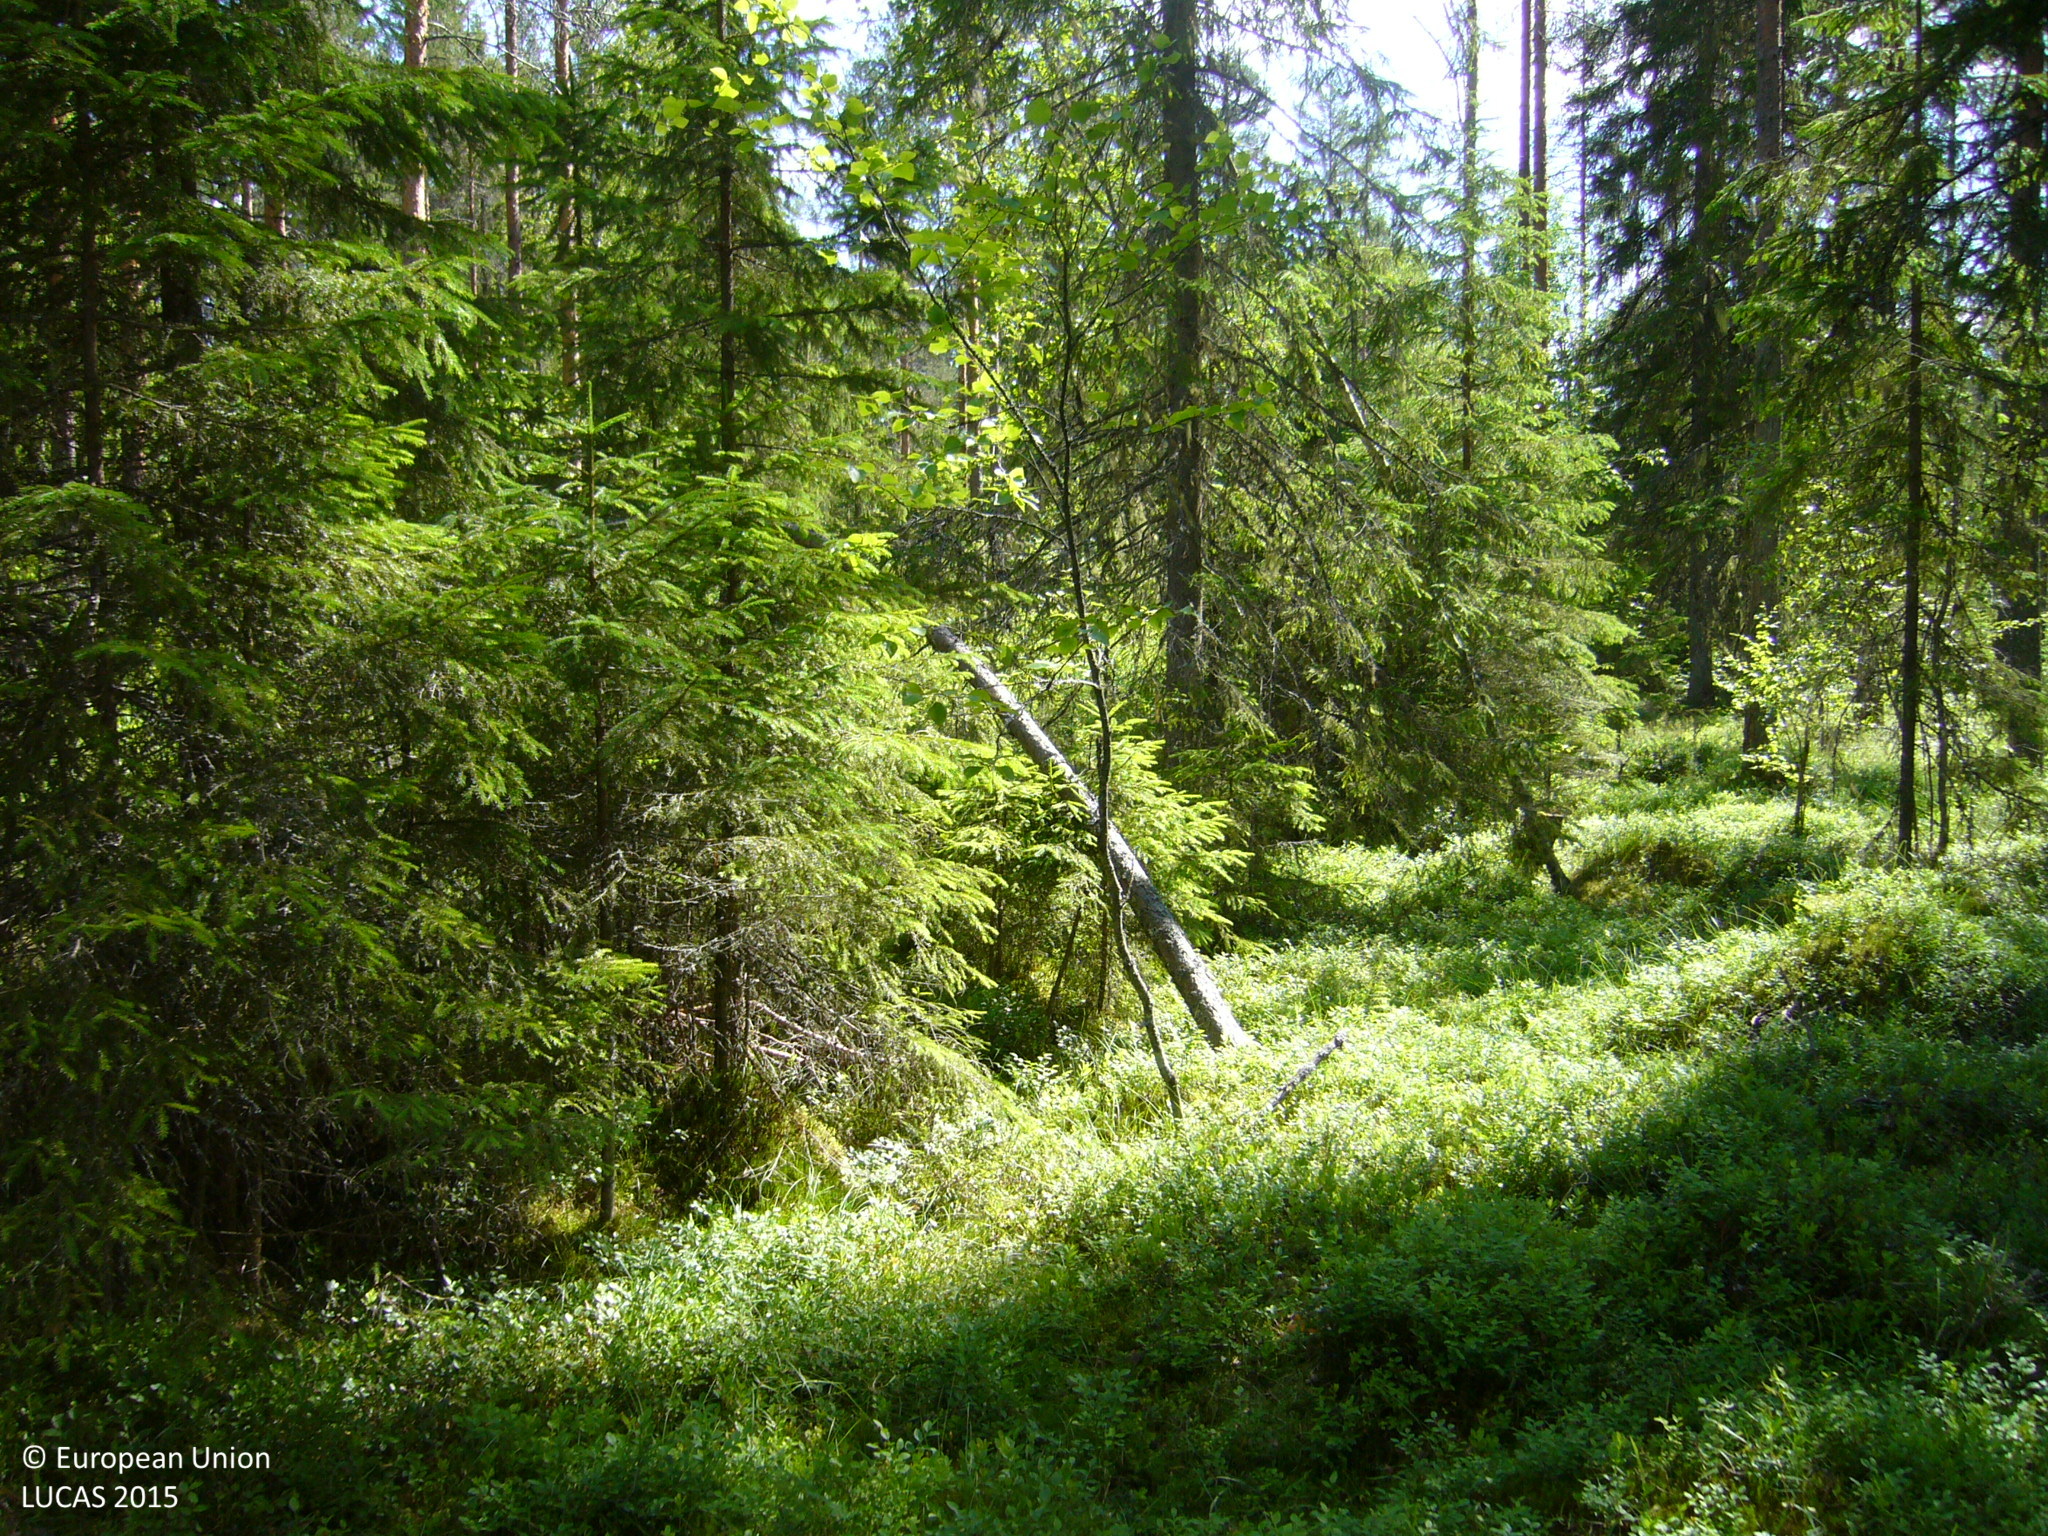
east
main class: Woodland
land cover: Spruce dominated coniferous woodland
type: boreal forest
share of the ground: 50 - 75 %
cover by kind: coniferous forest trees 50 %, shrubs 40 %, broadleaved forest trees 10 %
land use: Forestry
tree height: > 5 m
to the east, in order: Spruce dominated coniferous woodland; Ditches and canals; Spruce dominated coniferous woodland; Shruby margins; Ditches and canals; Grass margins; Tracks; Grass margins; Ditches and canals; Shruby margins; Pine dominated coniferous woodland; Spruce dominated coniferous woodland; Spruce dominated mixed woodland; Shruby margins; Ditches and canals; Grass margins; Paved roads, cycling and walking lanes
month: July
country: FI
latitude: 63.3094
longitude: 26.2662
